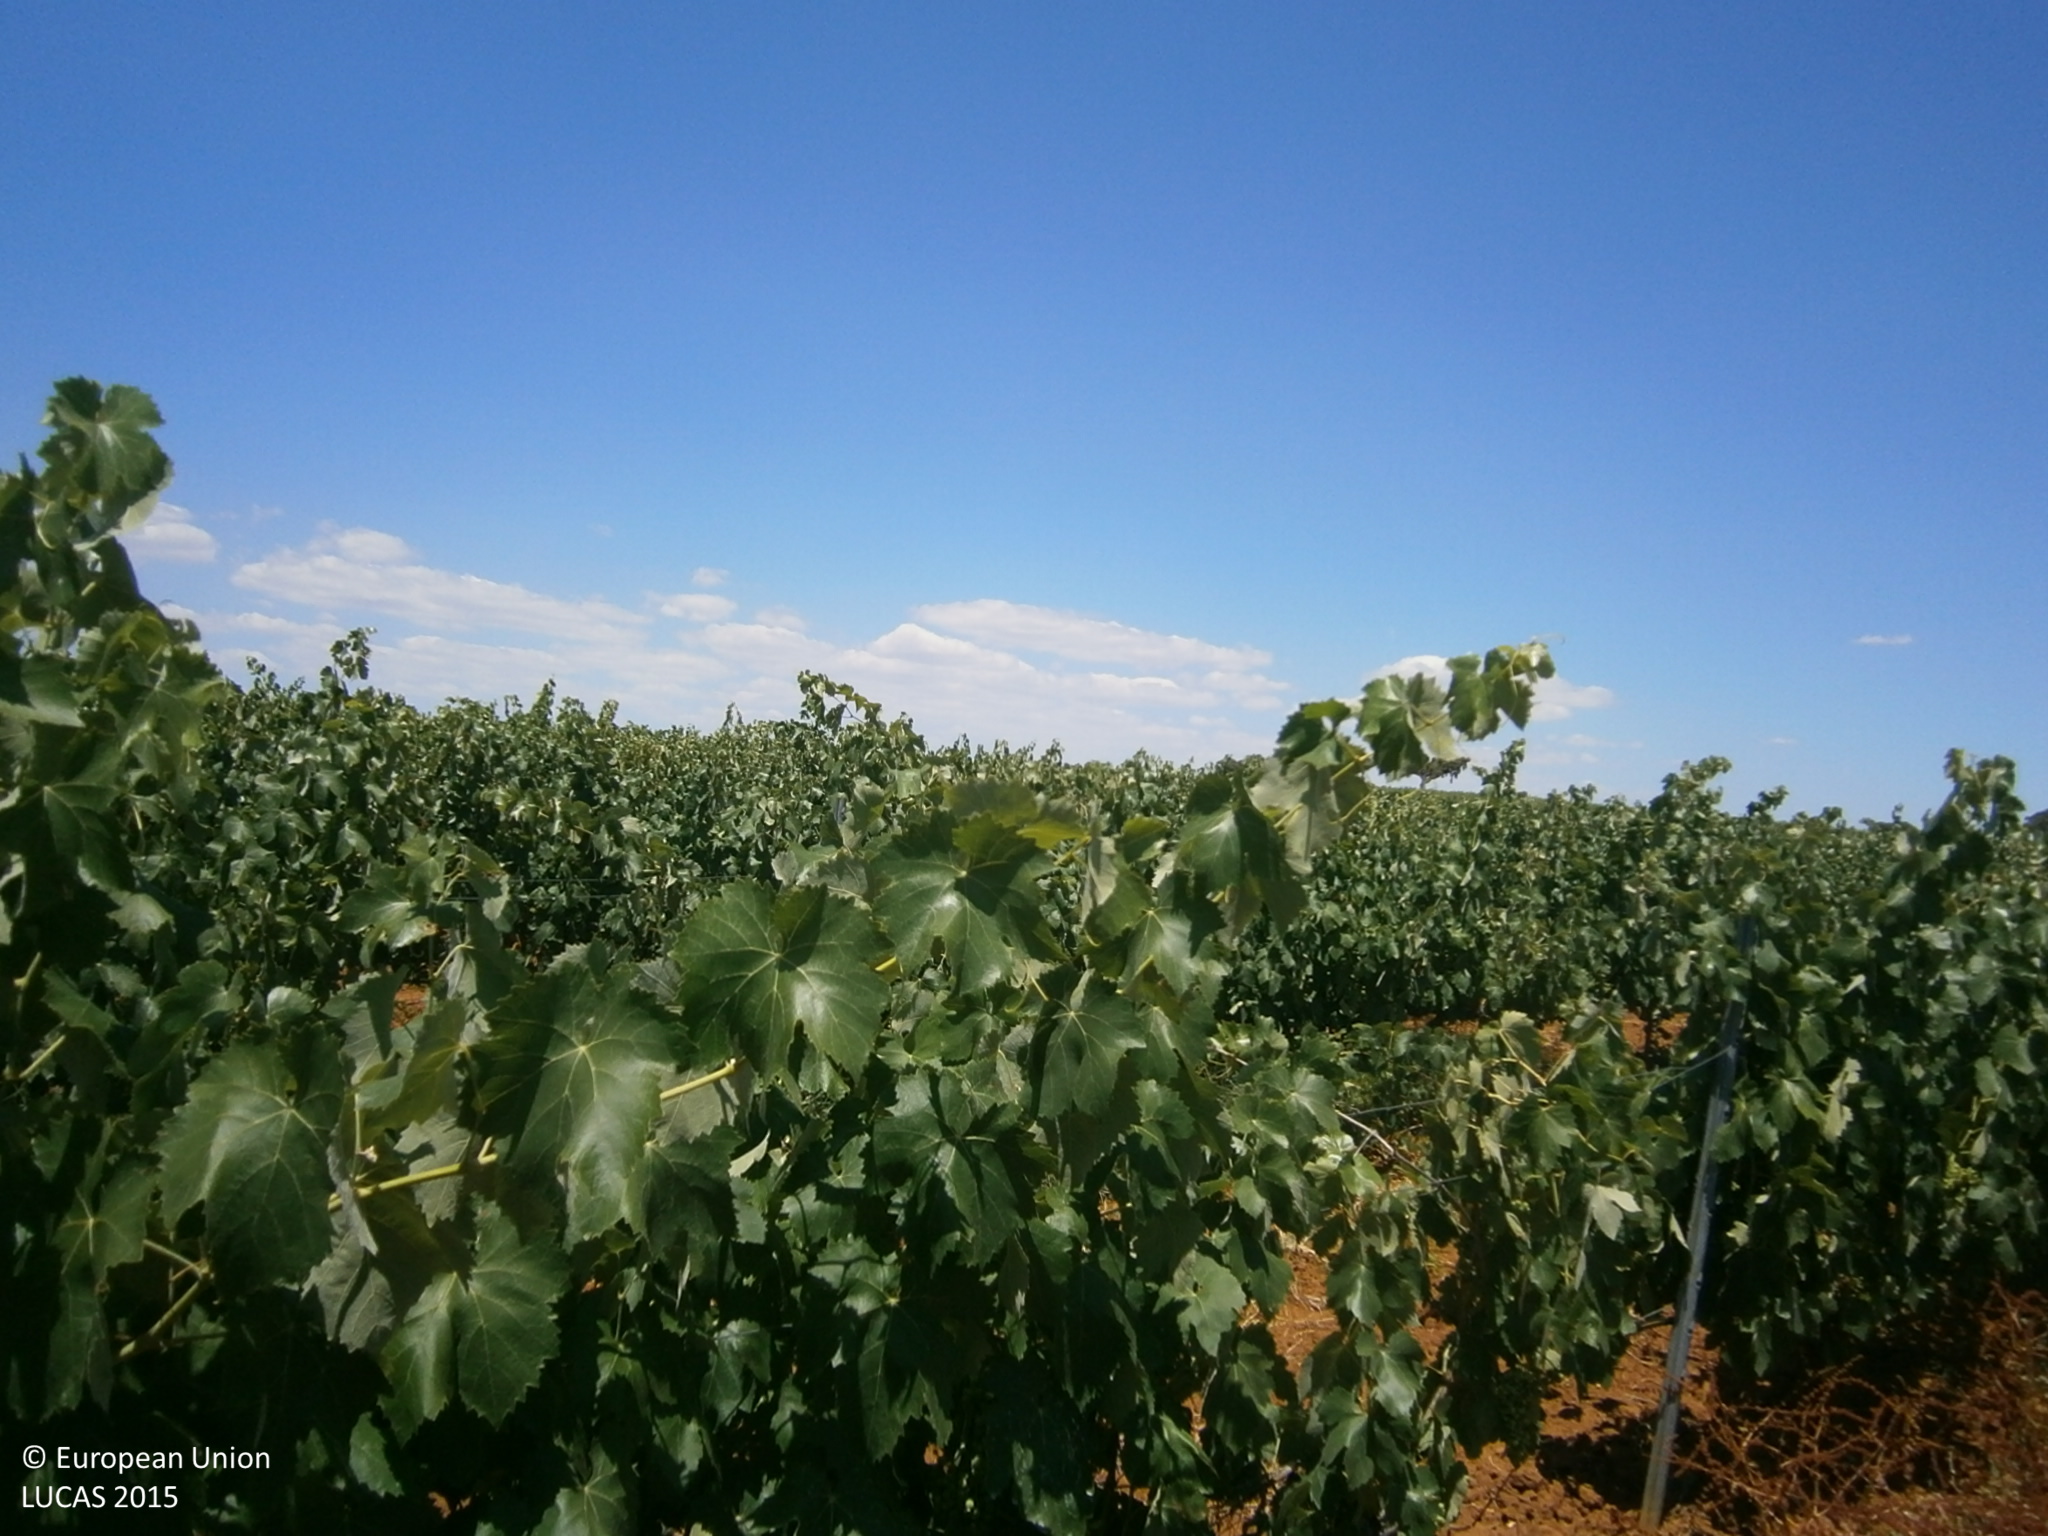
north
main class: Cropland
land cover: Vineyards
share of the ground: 50 - 75 %
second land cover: Spontaneously vegetated surfaces
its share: 10 - 25 %
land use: Agriculture (excluding fallow land and kitchen gardens)
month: June
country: ES
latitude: 38.7783
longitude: -6.6484
